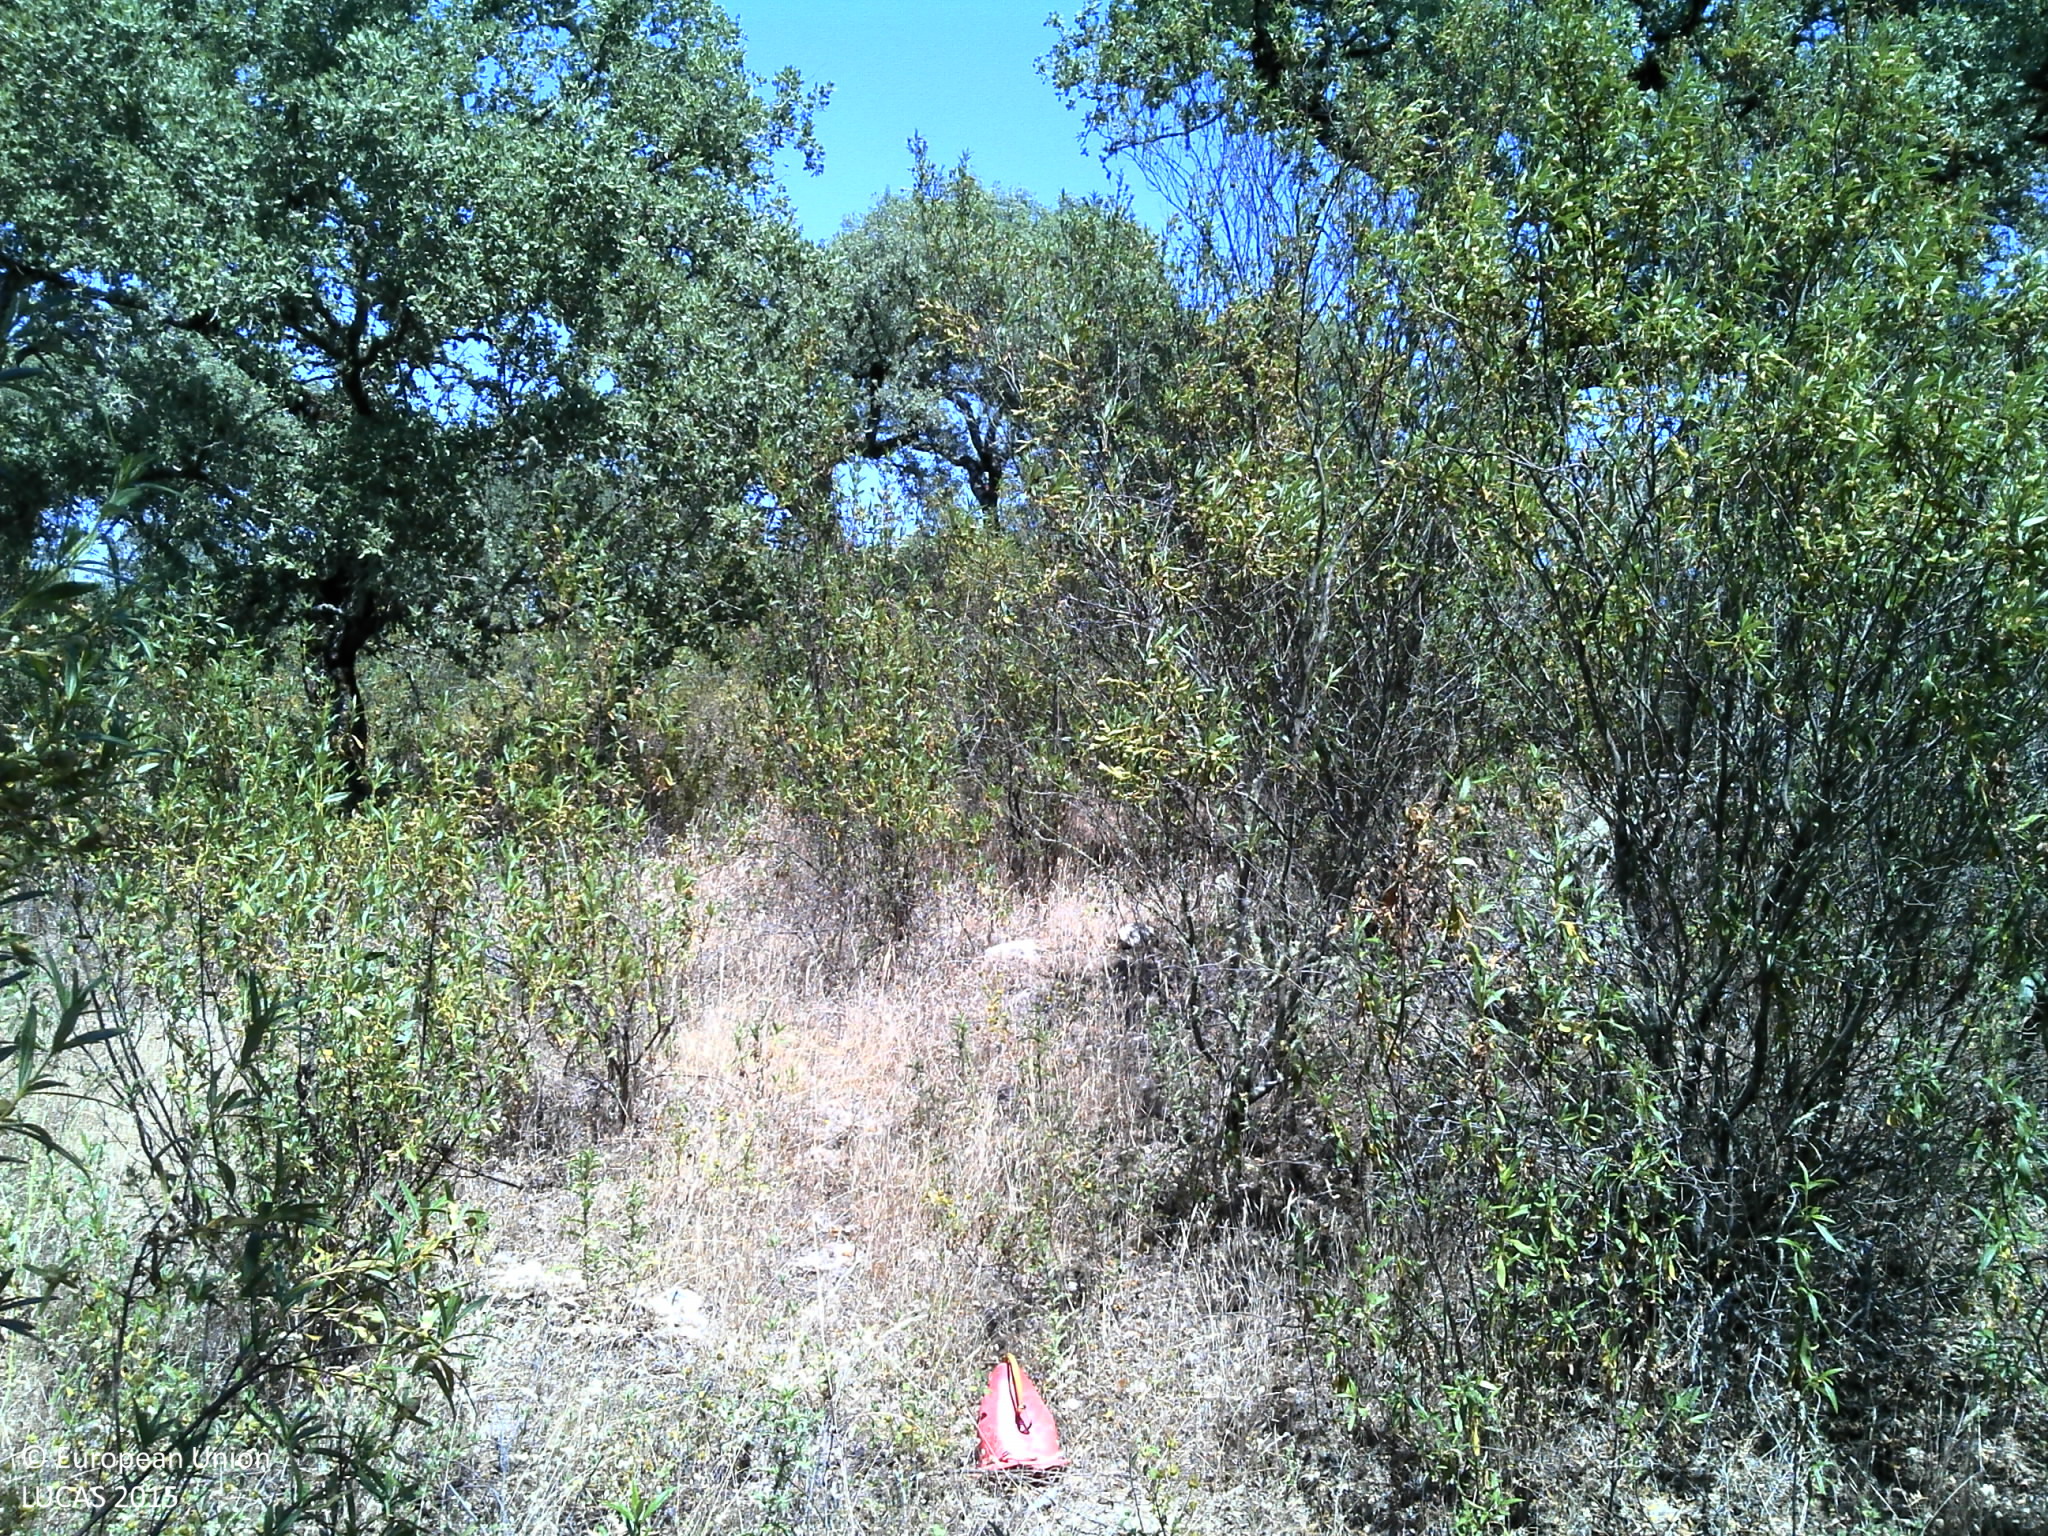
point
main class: Woodland
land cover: Broadleaved woodland
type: broadleaved evergreen forest
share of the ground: > 75 %
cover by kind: broadleaved forest trees 75 %, shrubs 20 %, herbaceous plants 5 %
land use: Forestry
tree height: > 5 m
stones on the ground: < 10 %
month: May
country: PT
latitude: 38.7700
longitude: -8.1066
